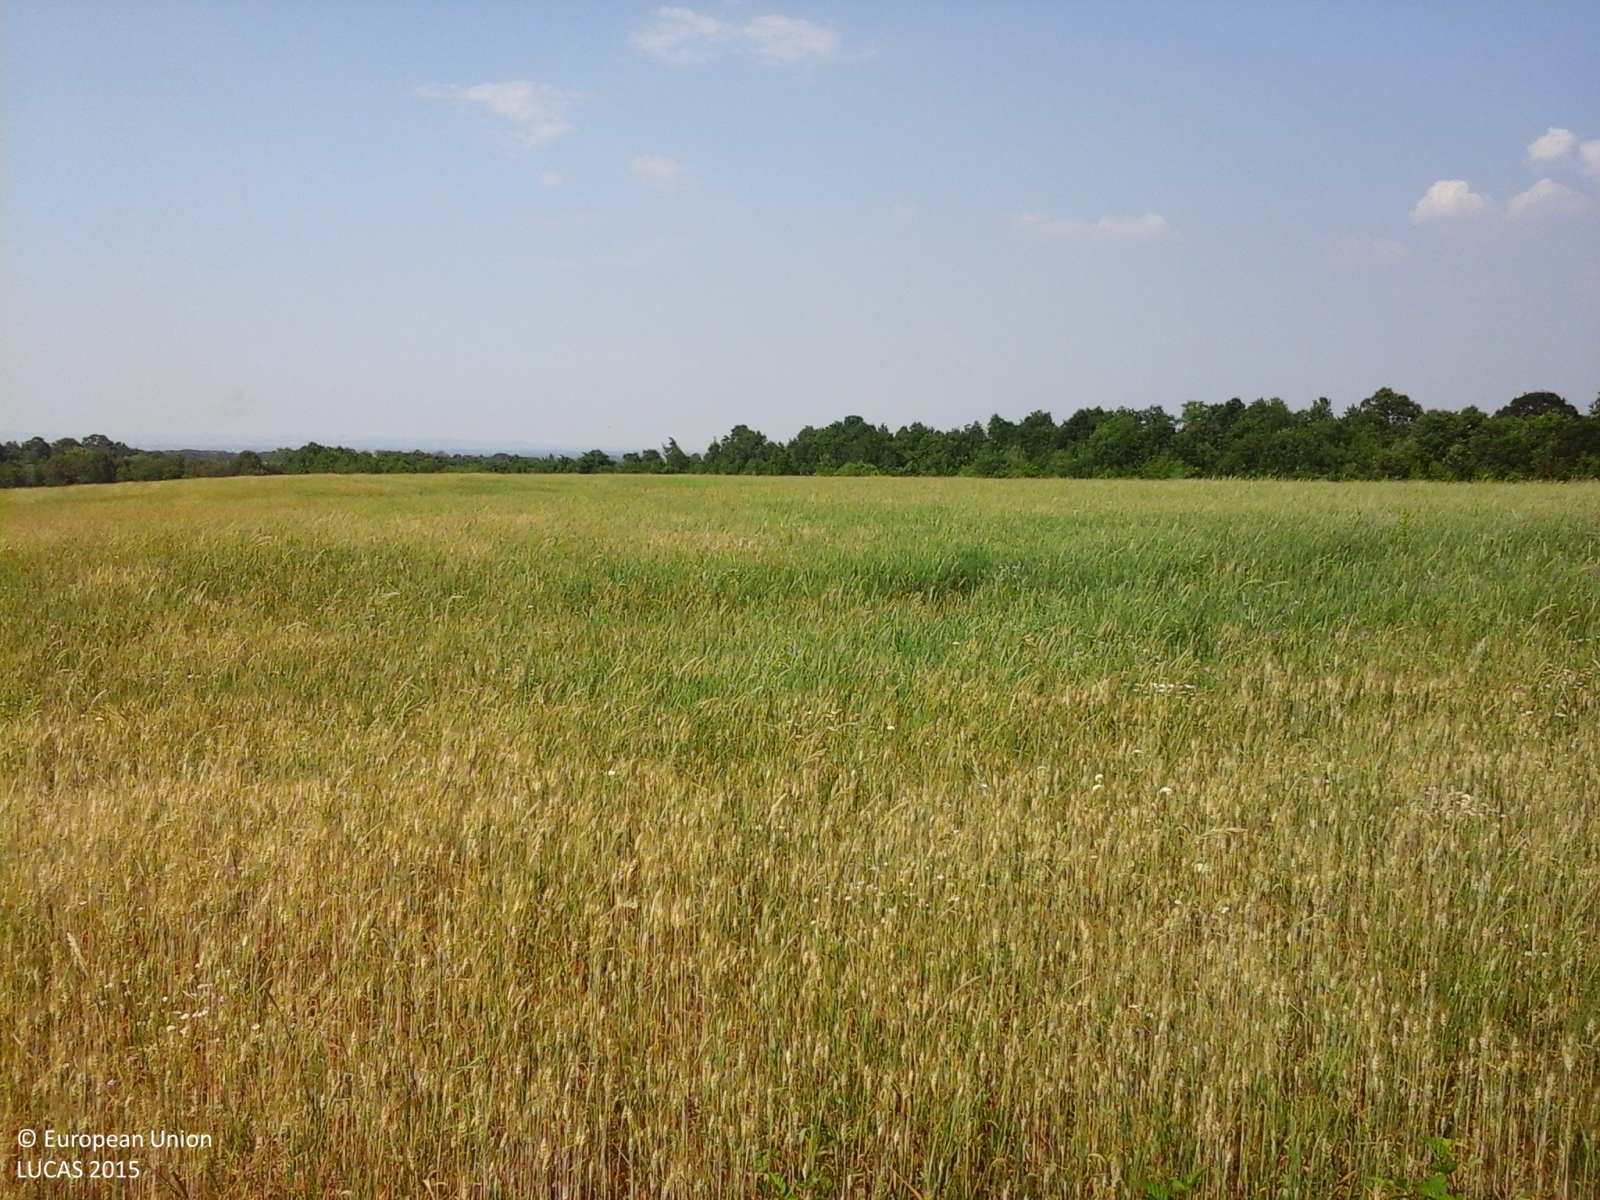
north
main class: Cropland
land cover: Common wheat
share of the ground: > 75 %
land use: Agriculture (excluding fallow land and kitchen gardens)
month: June
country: IT
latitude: 44.7199
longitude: 8.6016
